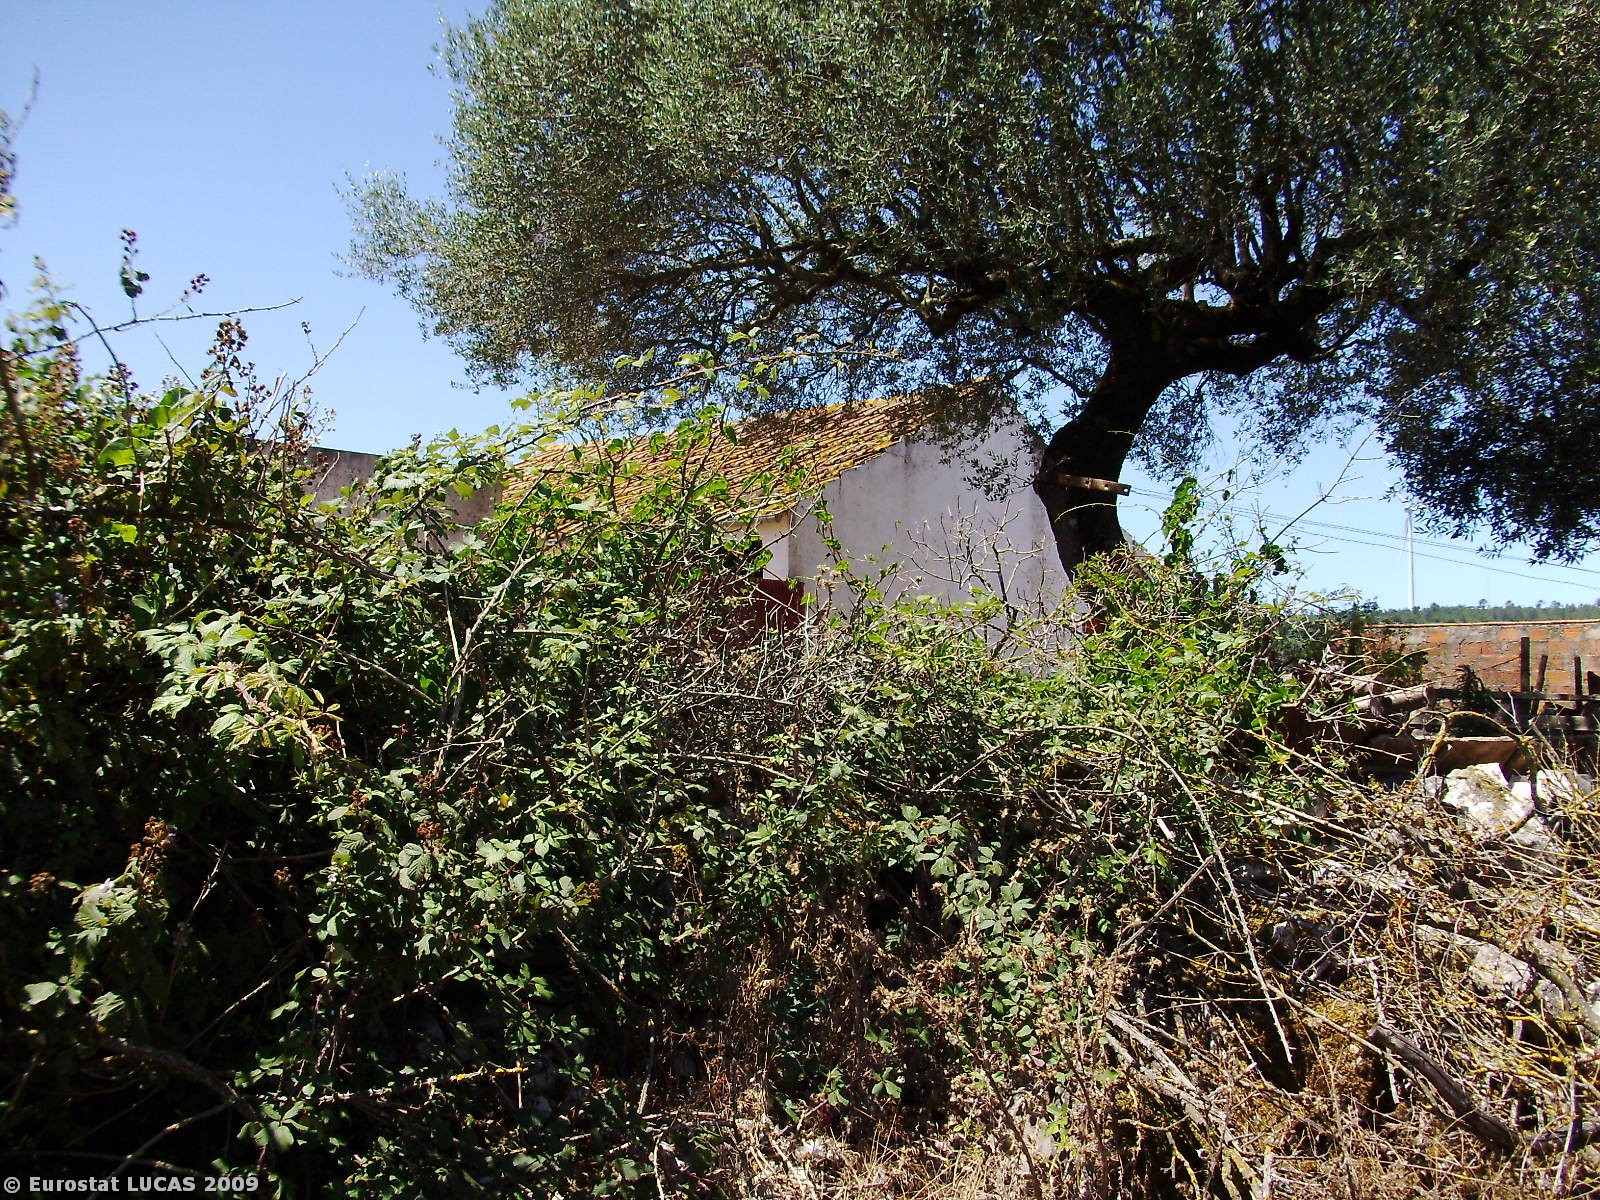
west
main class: Grassland
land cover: Spontaneously vegetated surfaces
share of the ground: > 75 %
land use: Fallow land
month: July
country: PT
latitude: 39.4492
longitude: -8.8963
